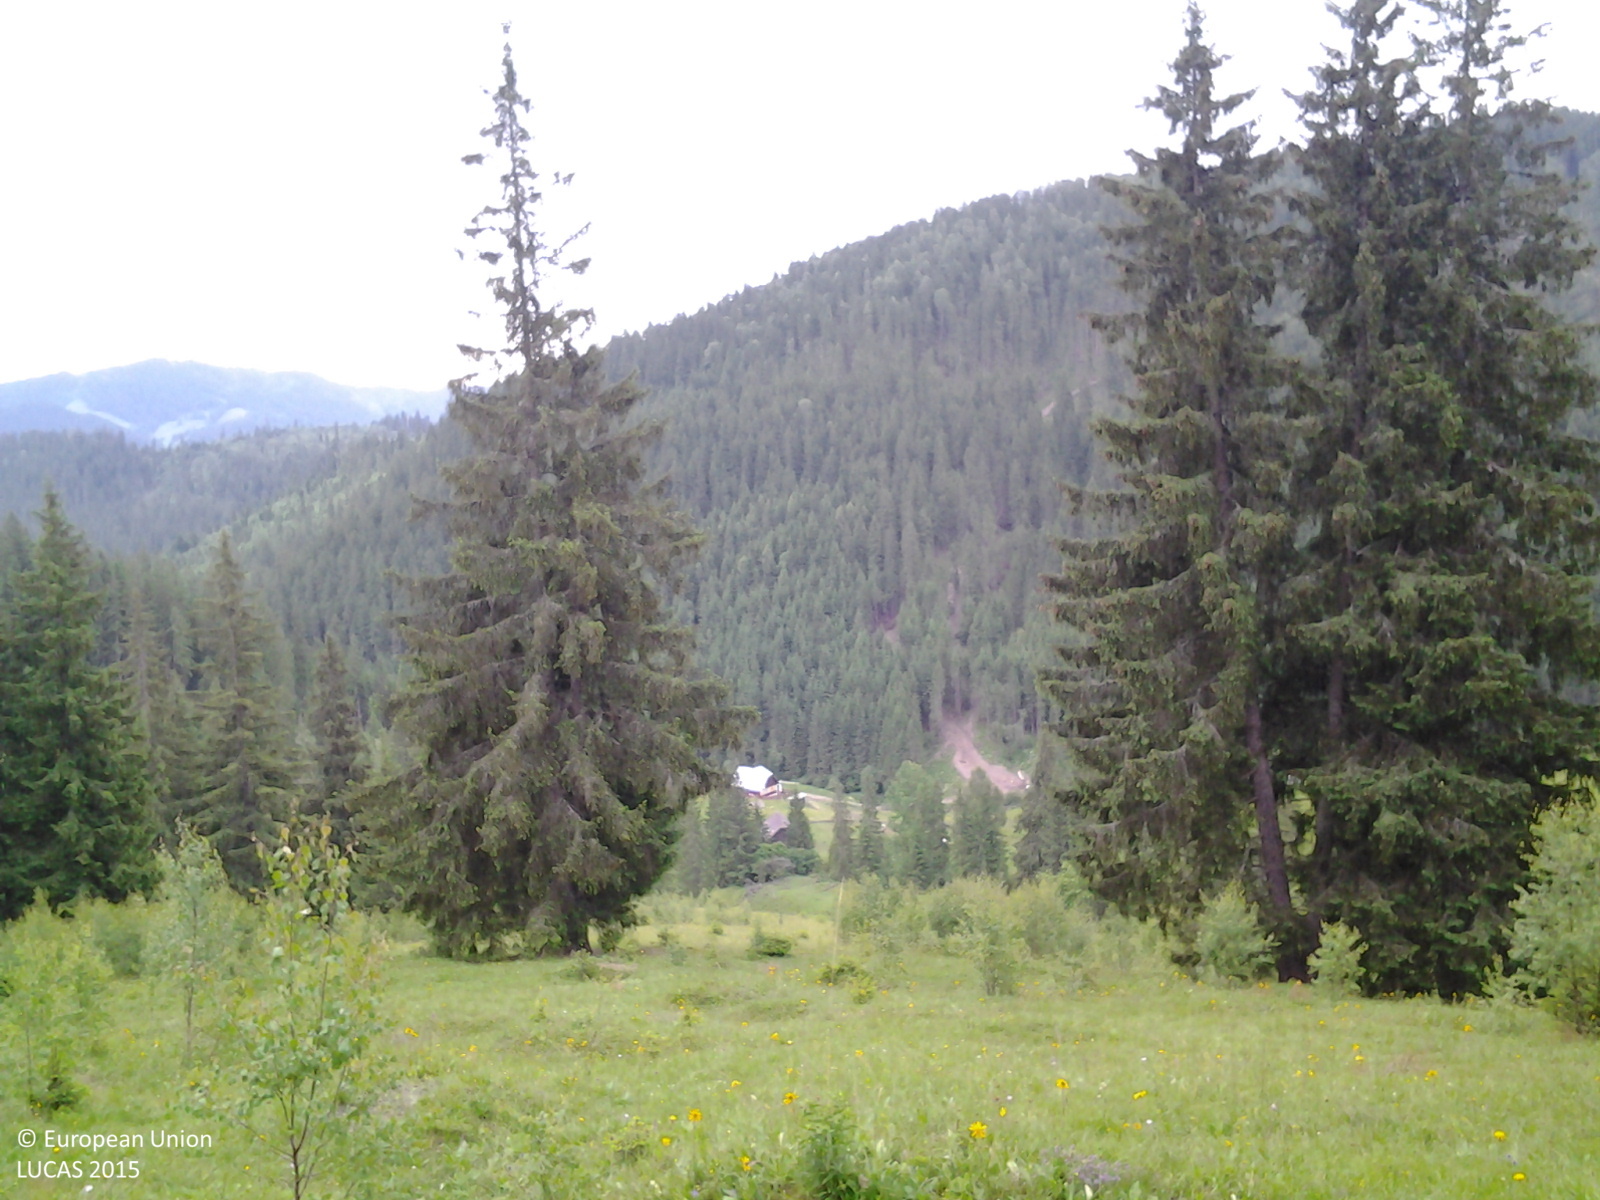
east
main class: Grassland
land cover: Grassland with sparse tree/shrub cover
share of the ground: > 75 %
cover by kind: herbaceous plants 85 %, shrubs 10 %, coniferous forest trees 5 %
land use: Agriculture (excluding fallow land and kitchen gardens)
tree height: > 5 m
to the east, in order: Grassland with sparse tree/shrub cover; Grassland without tree/shrub cover; Grassland with sparse tree/shrub cover; Lines of trees; Grassland with sparse tree/shrub cover
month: June
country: RO
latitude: 47.7553
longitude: 25.1433
